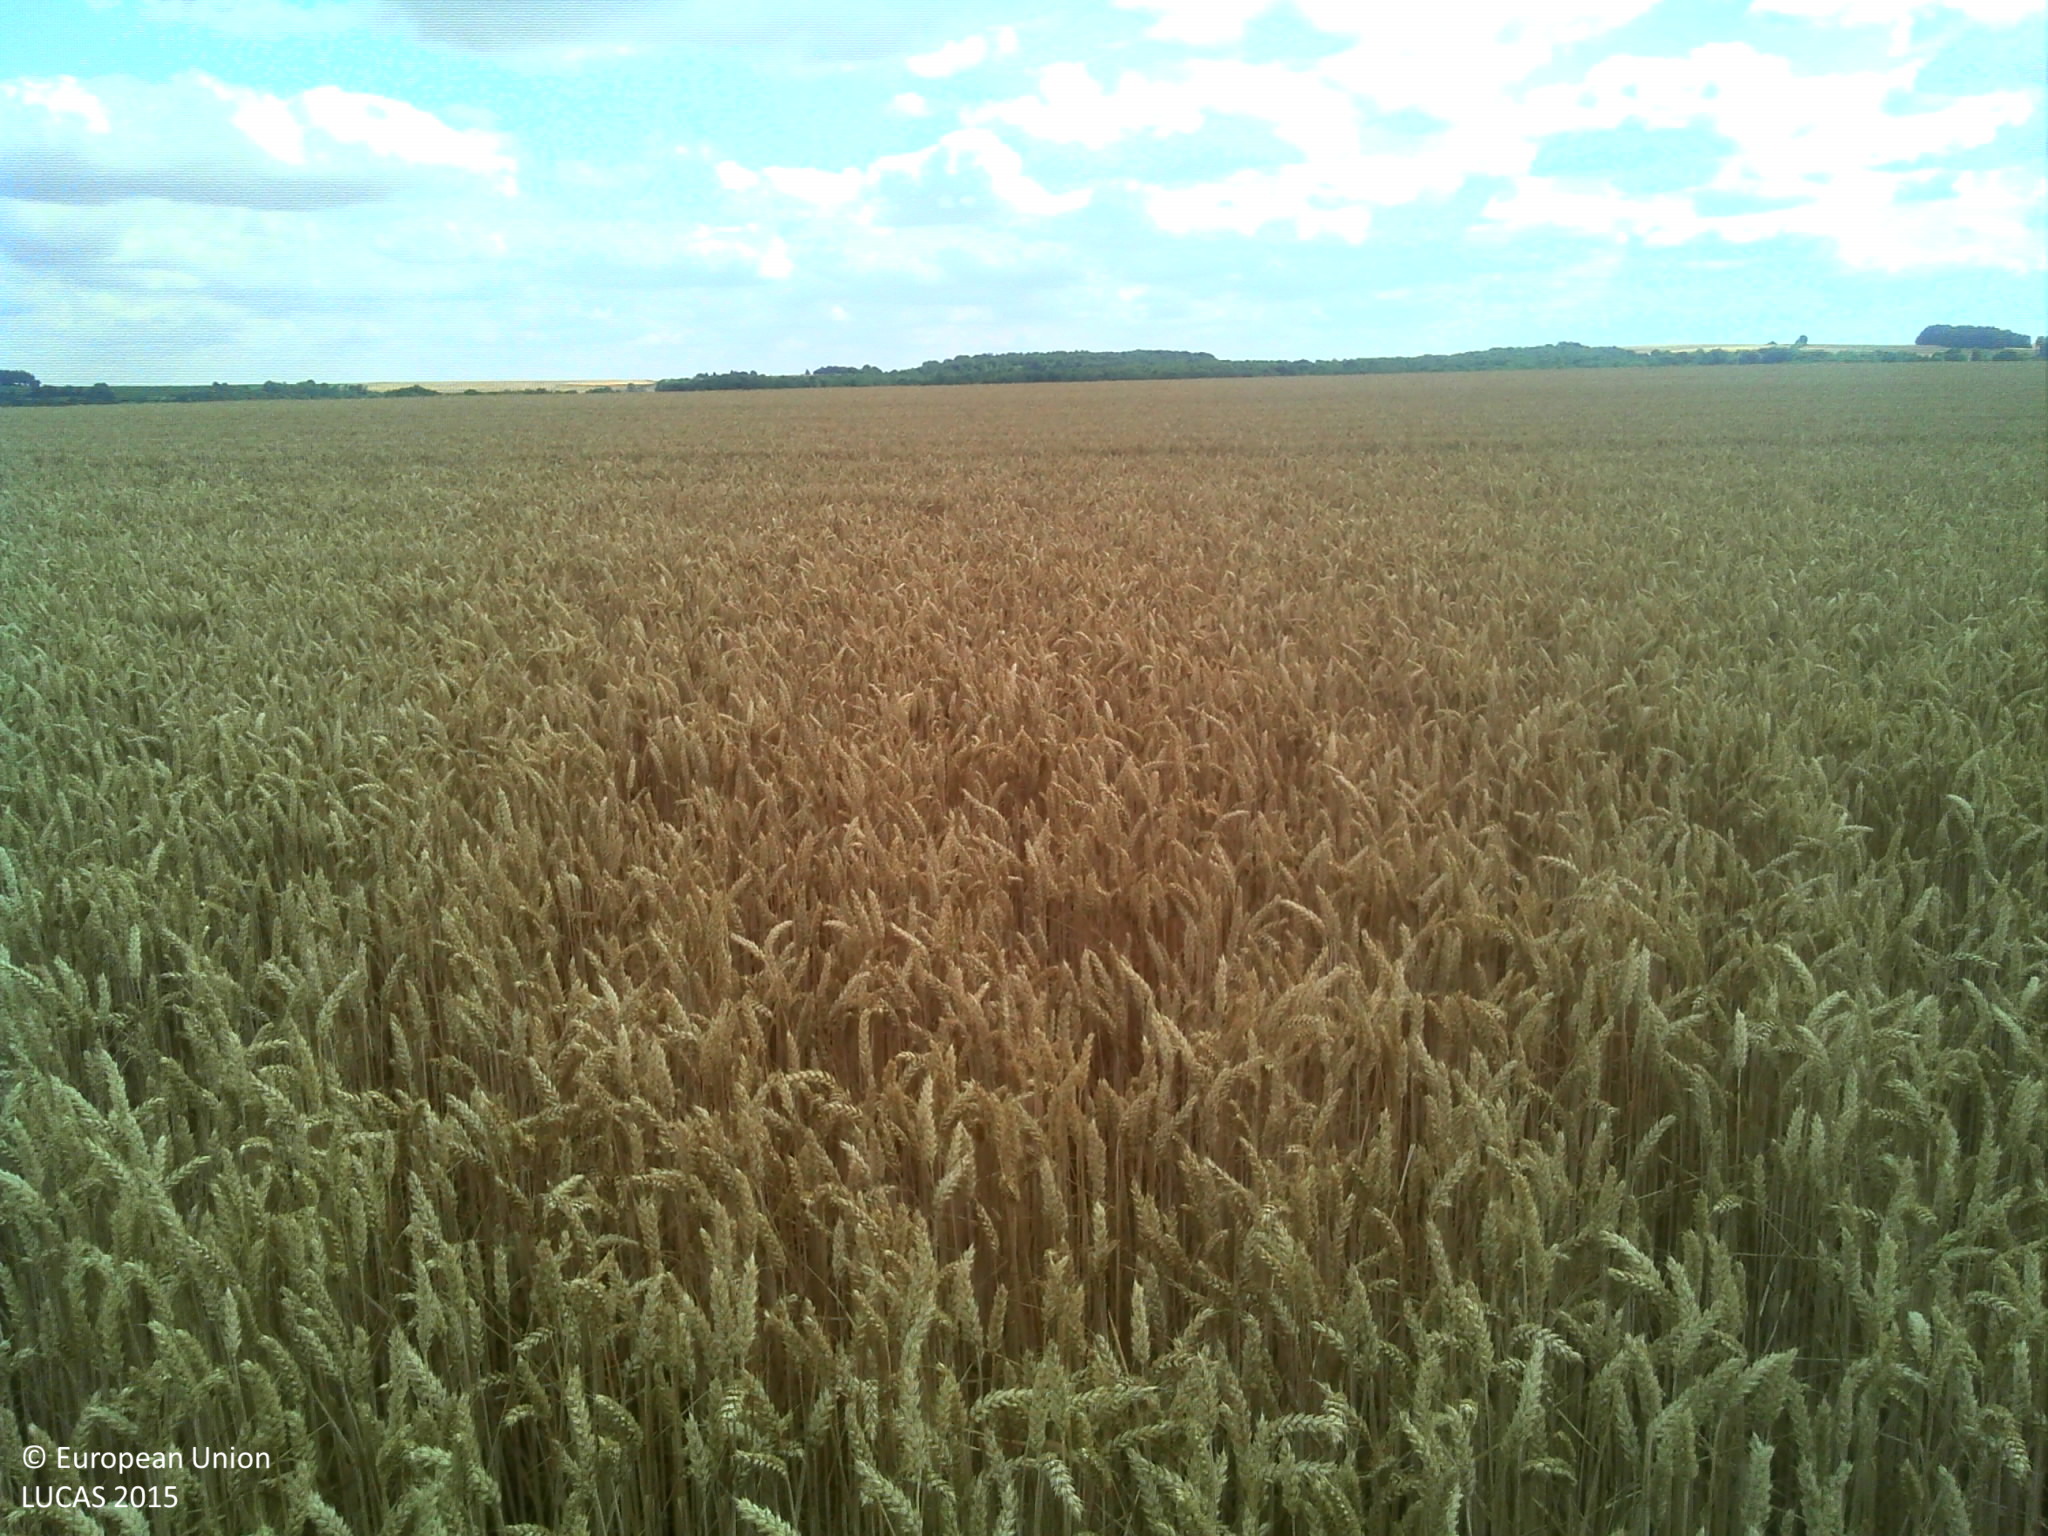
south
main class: Cropland
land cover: Common wheat
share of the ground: > 75 %
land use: Agriculture (excluding fallow land and kitchen gardens)
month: July
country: FR
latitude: 49.2831
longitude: 3.2973
